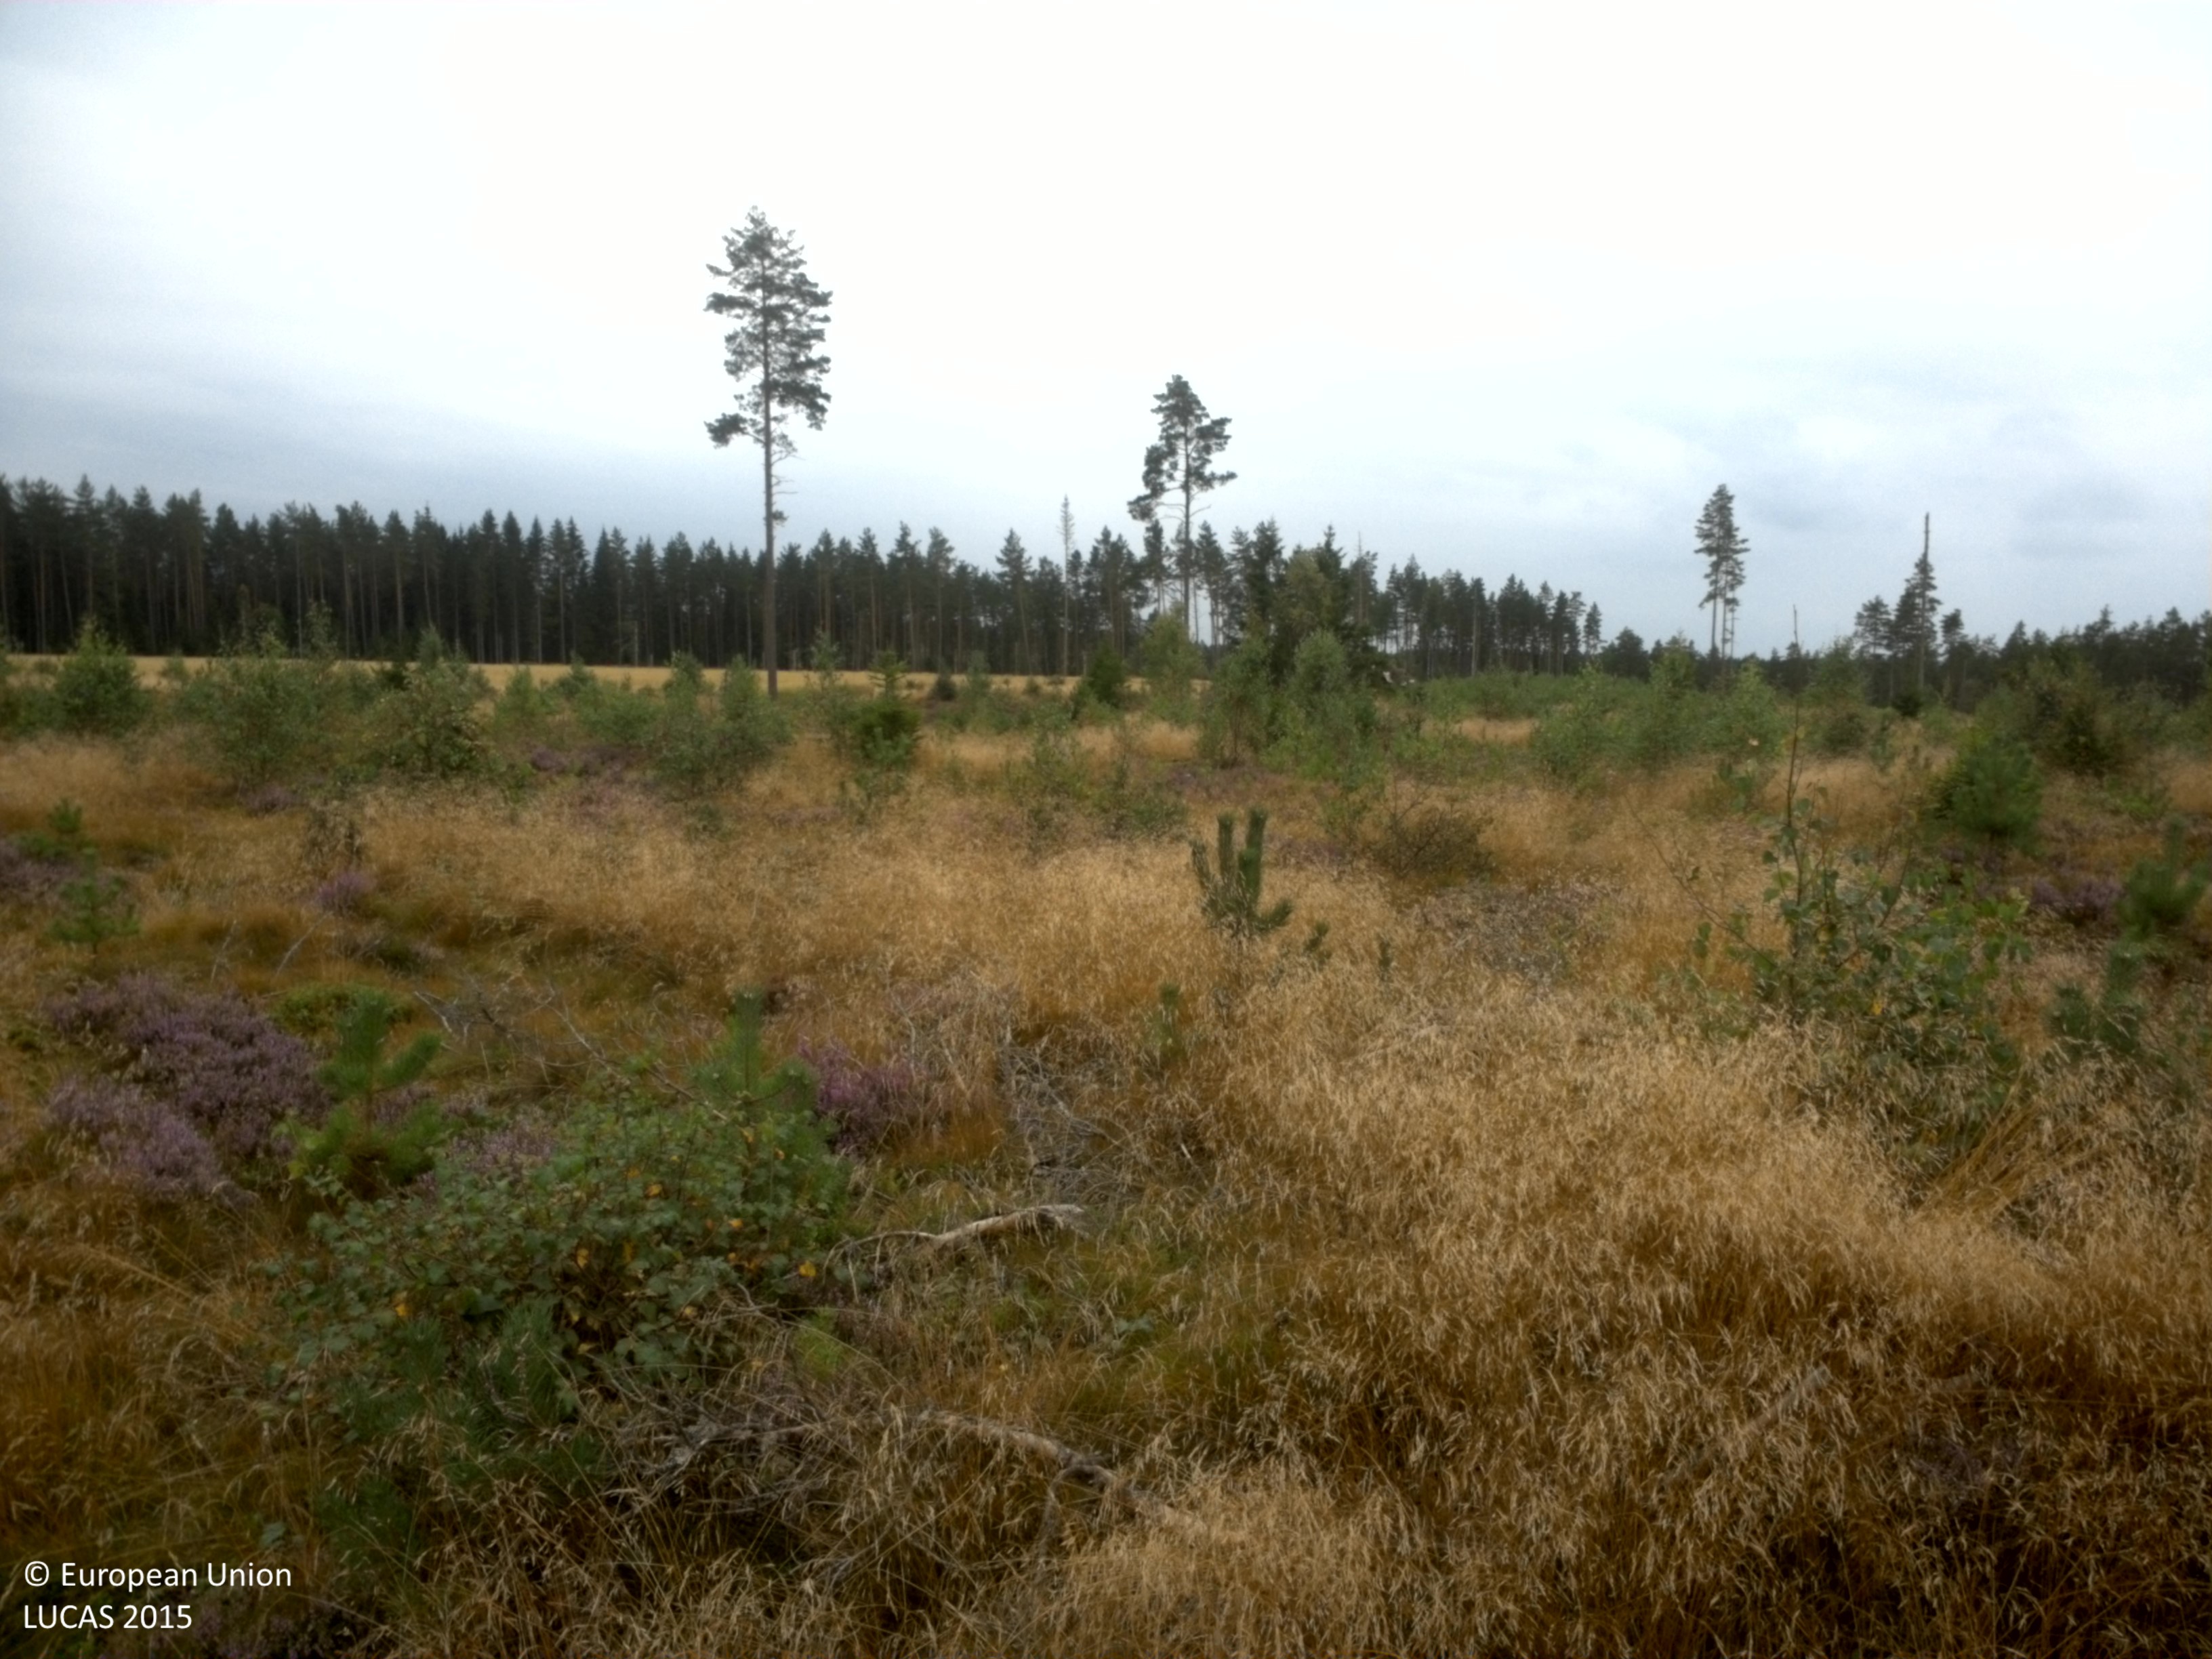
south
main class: Woodland
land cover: Pine dominated mixed woodland
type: boreal forest
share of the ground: 10 - 25 %
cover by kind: herbaceous plants 60 %, coniferous forest trees 15 %, shrubs 15 %, broadleaved forest trees 10 %
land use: Forestry
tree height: < 5 m
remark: Clear cut
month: August
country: SE
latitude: 57.8751
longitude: 13.8896
